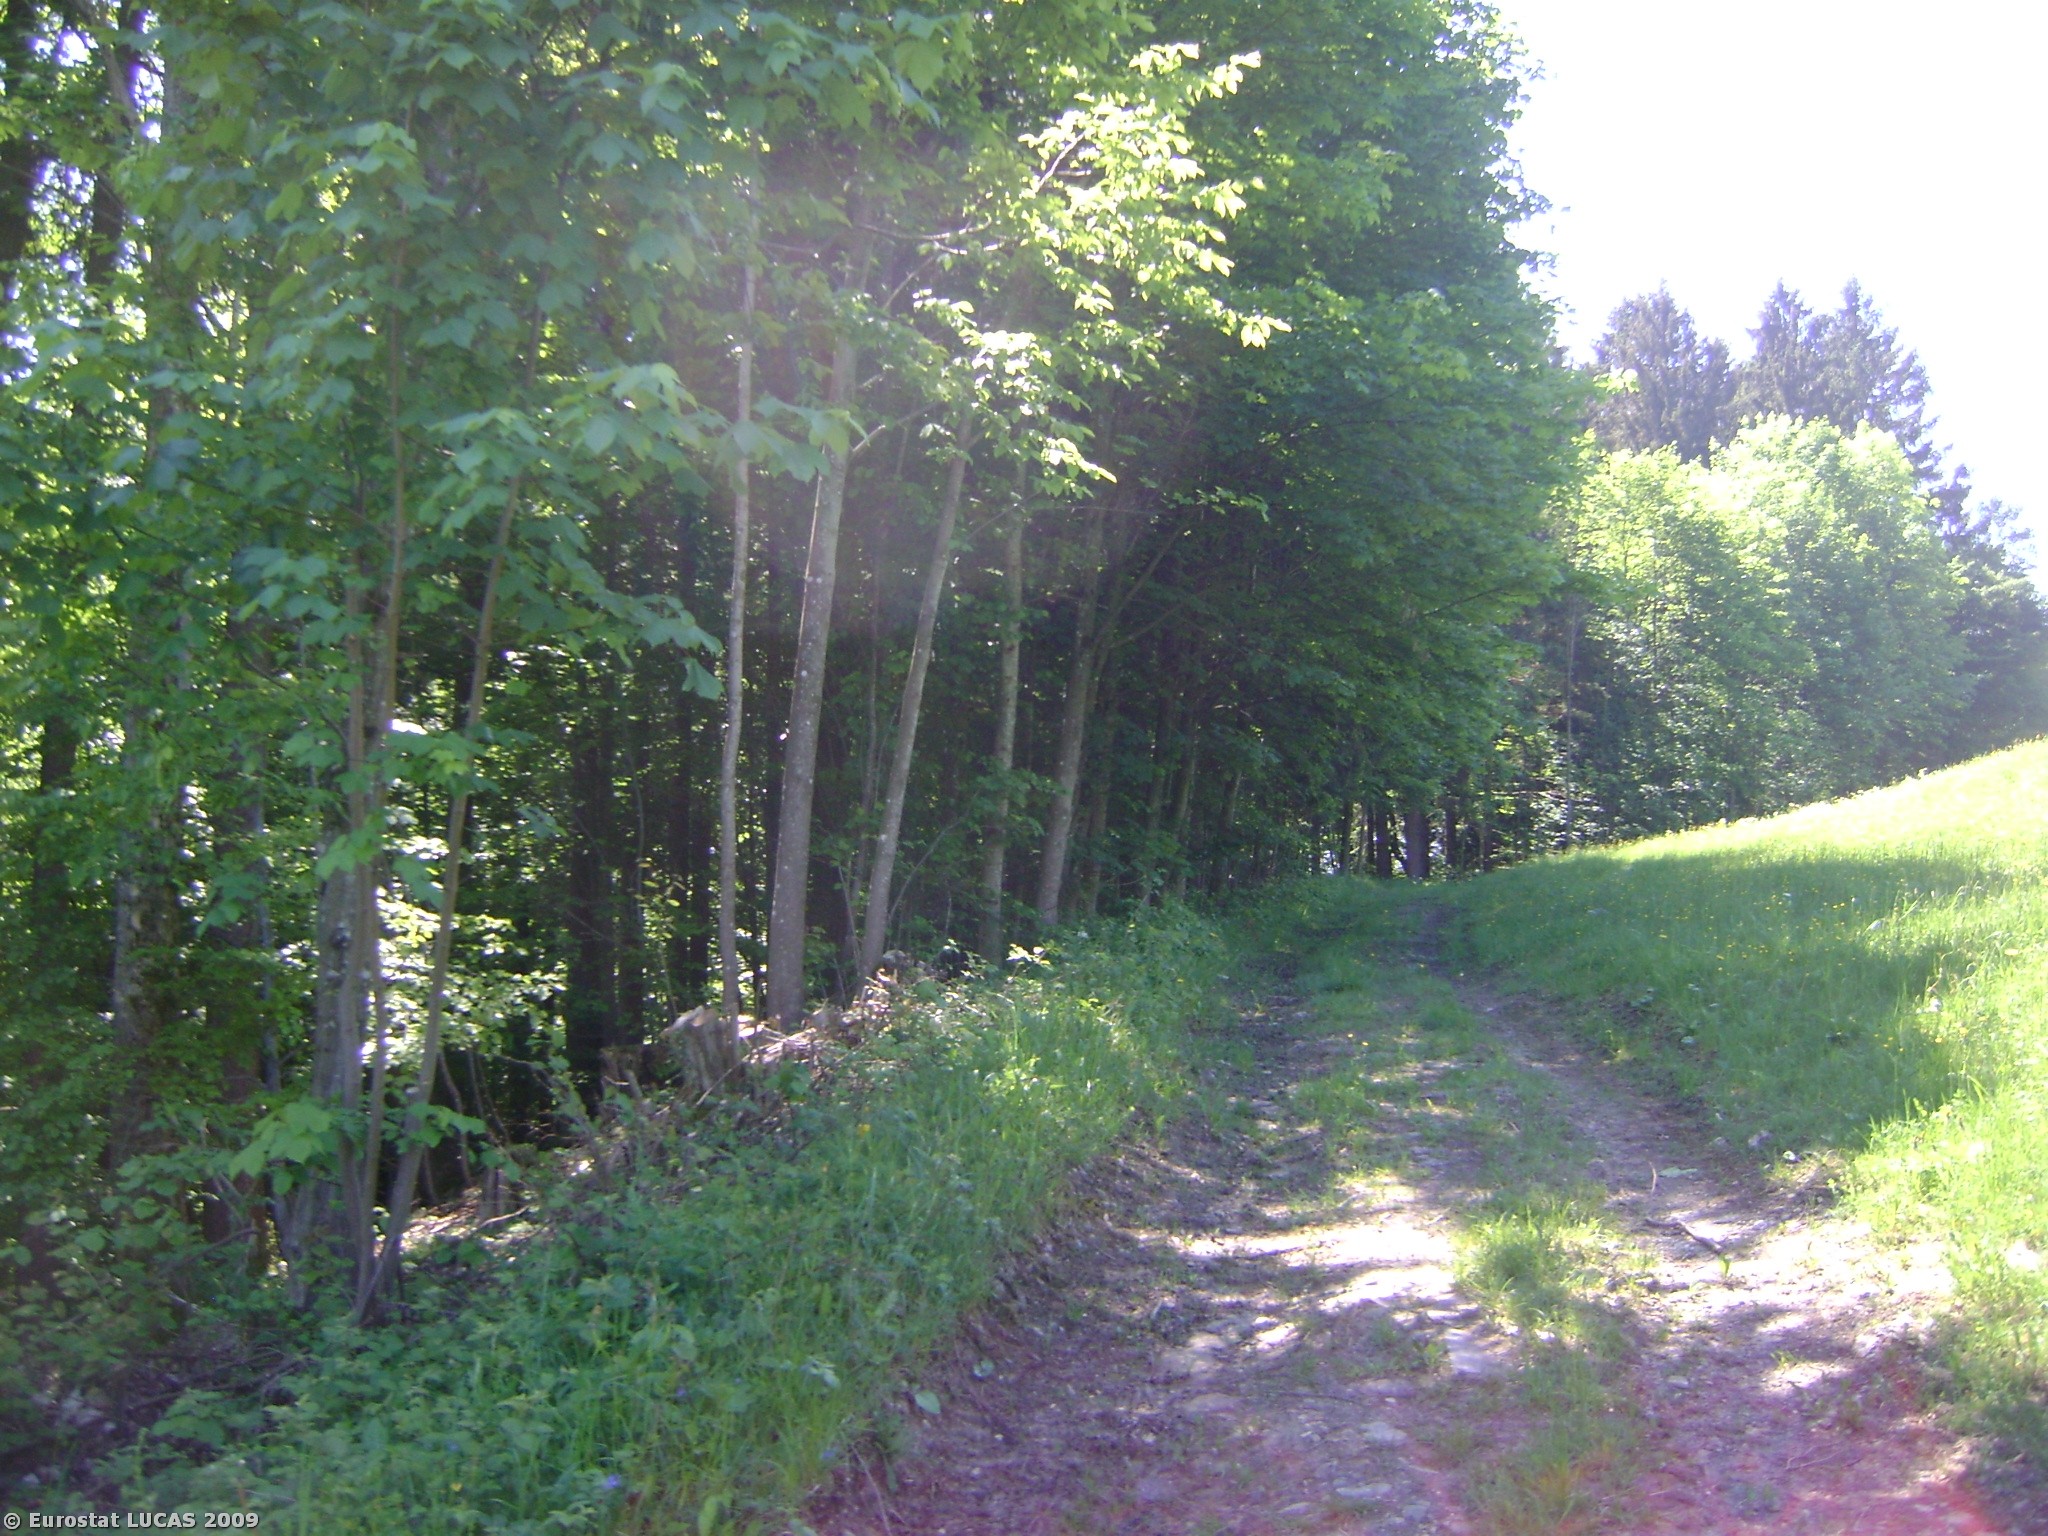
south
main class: Grassland
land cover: Grassland without tree/shrub cover
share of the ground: > 75 %
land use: Agriculture (excluding fallow land and kitchen gardens)
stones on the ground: < 10 %
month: May
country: AT
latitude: 47.8434
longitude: 13.5131
